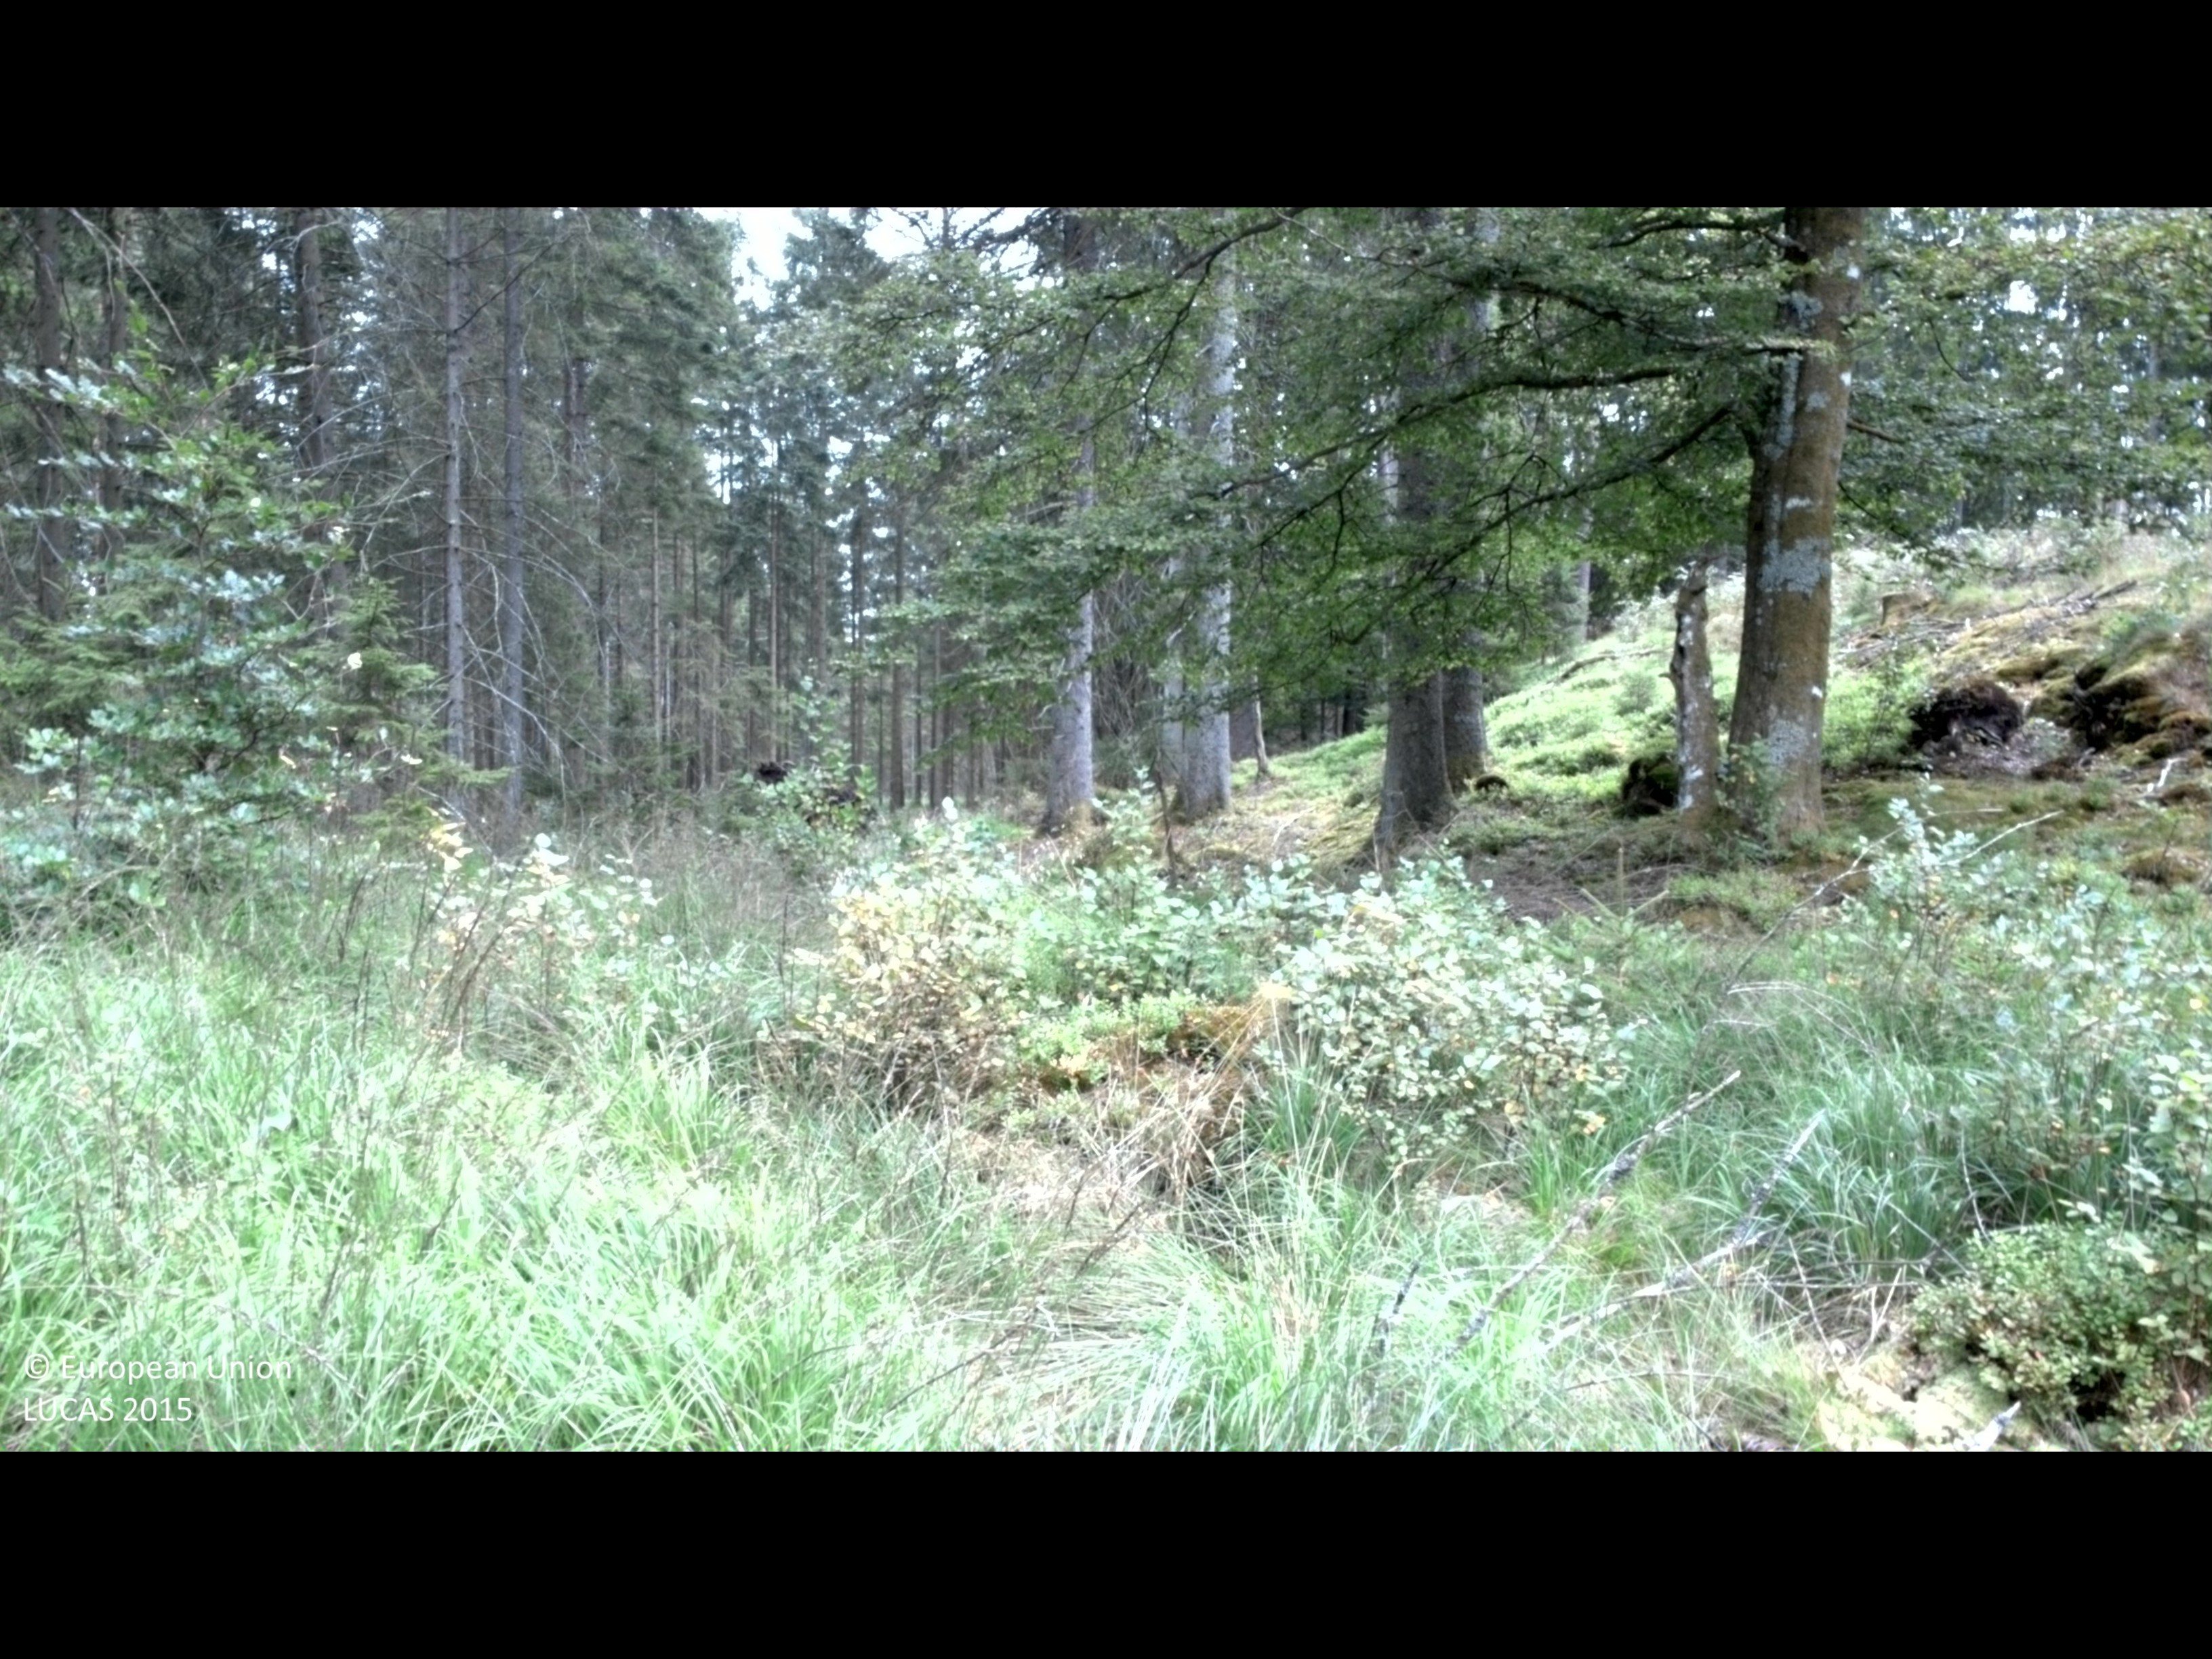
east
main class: Grassland
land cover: Grassland with sparse tree/shrub cover
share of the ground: > 75 %
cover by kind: herbaceous plants 90 %, broadleaved forest trees 5 %, shrubs 5 %
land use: Forestry
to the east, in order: Grassland with sparse tree/shrub cover; Spruce dominated mixed woodland; Spruce dominated coniferous woodland; Ditches and canals; Spruce dominated coniferous woodland; Shrubland with sparse tree cover; Electric lines; Shrubland with sparse tree cover; Spruce dominated coniferous woodland; Ditches and canals; Spruce dominated mixed woodland; Pine dominated coniferous woodland
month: August
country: SE
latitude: 56.8490
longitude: 13.2266
